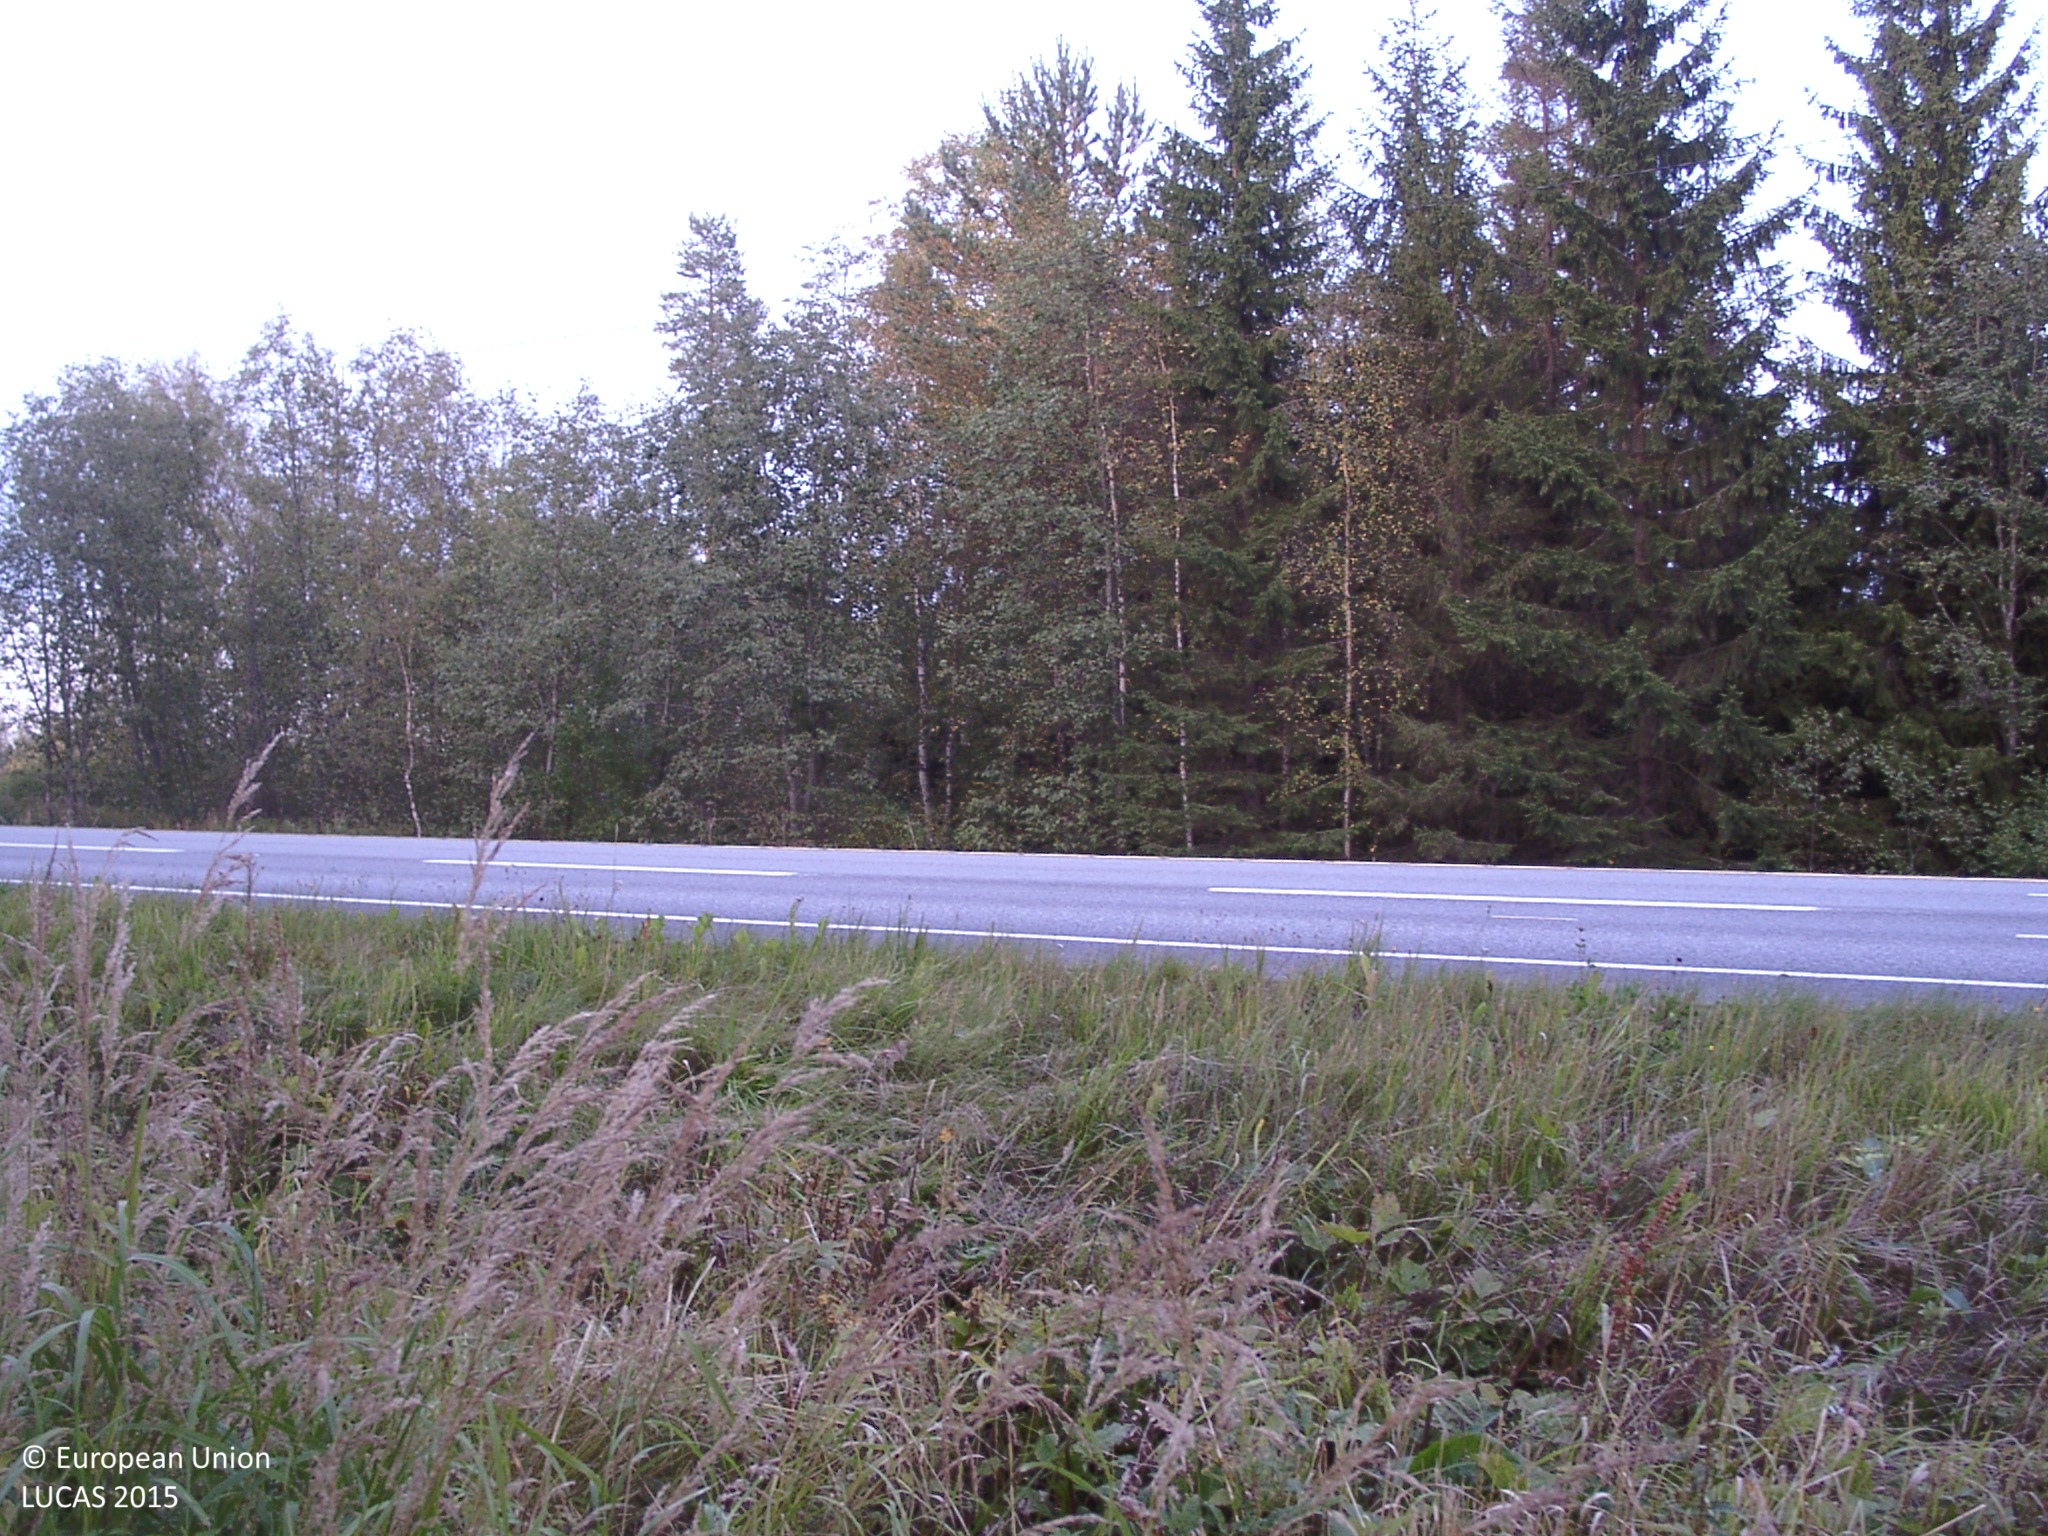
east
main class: Grassland
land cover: Grassland without tree/shrub cover
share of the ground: > 75 %
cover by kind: herbaceous plants 100 %
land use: Road transport
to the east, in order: Grassland without tree/shrub cover; Electric lines; Paved roads, cycling and walking lanes; Electric lines; Grassland without tree/shrub cover; Spruce dominated mixed woodland; Broadleaved woodland; Spruce dominated mixed woodland; Shrubland with sparse tree cover; Spontaneously vegetated surfaces; Ditches and canals; Shrubland without tree cover; Spontaneously vegetated surfaces; Tracks; Broadleaved woodland
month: September
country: FI
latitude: 62.4087
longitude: 25.6970
